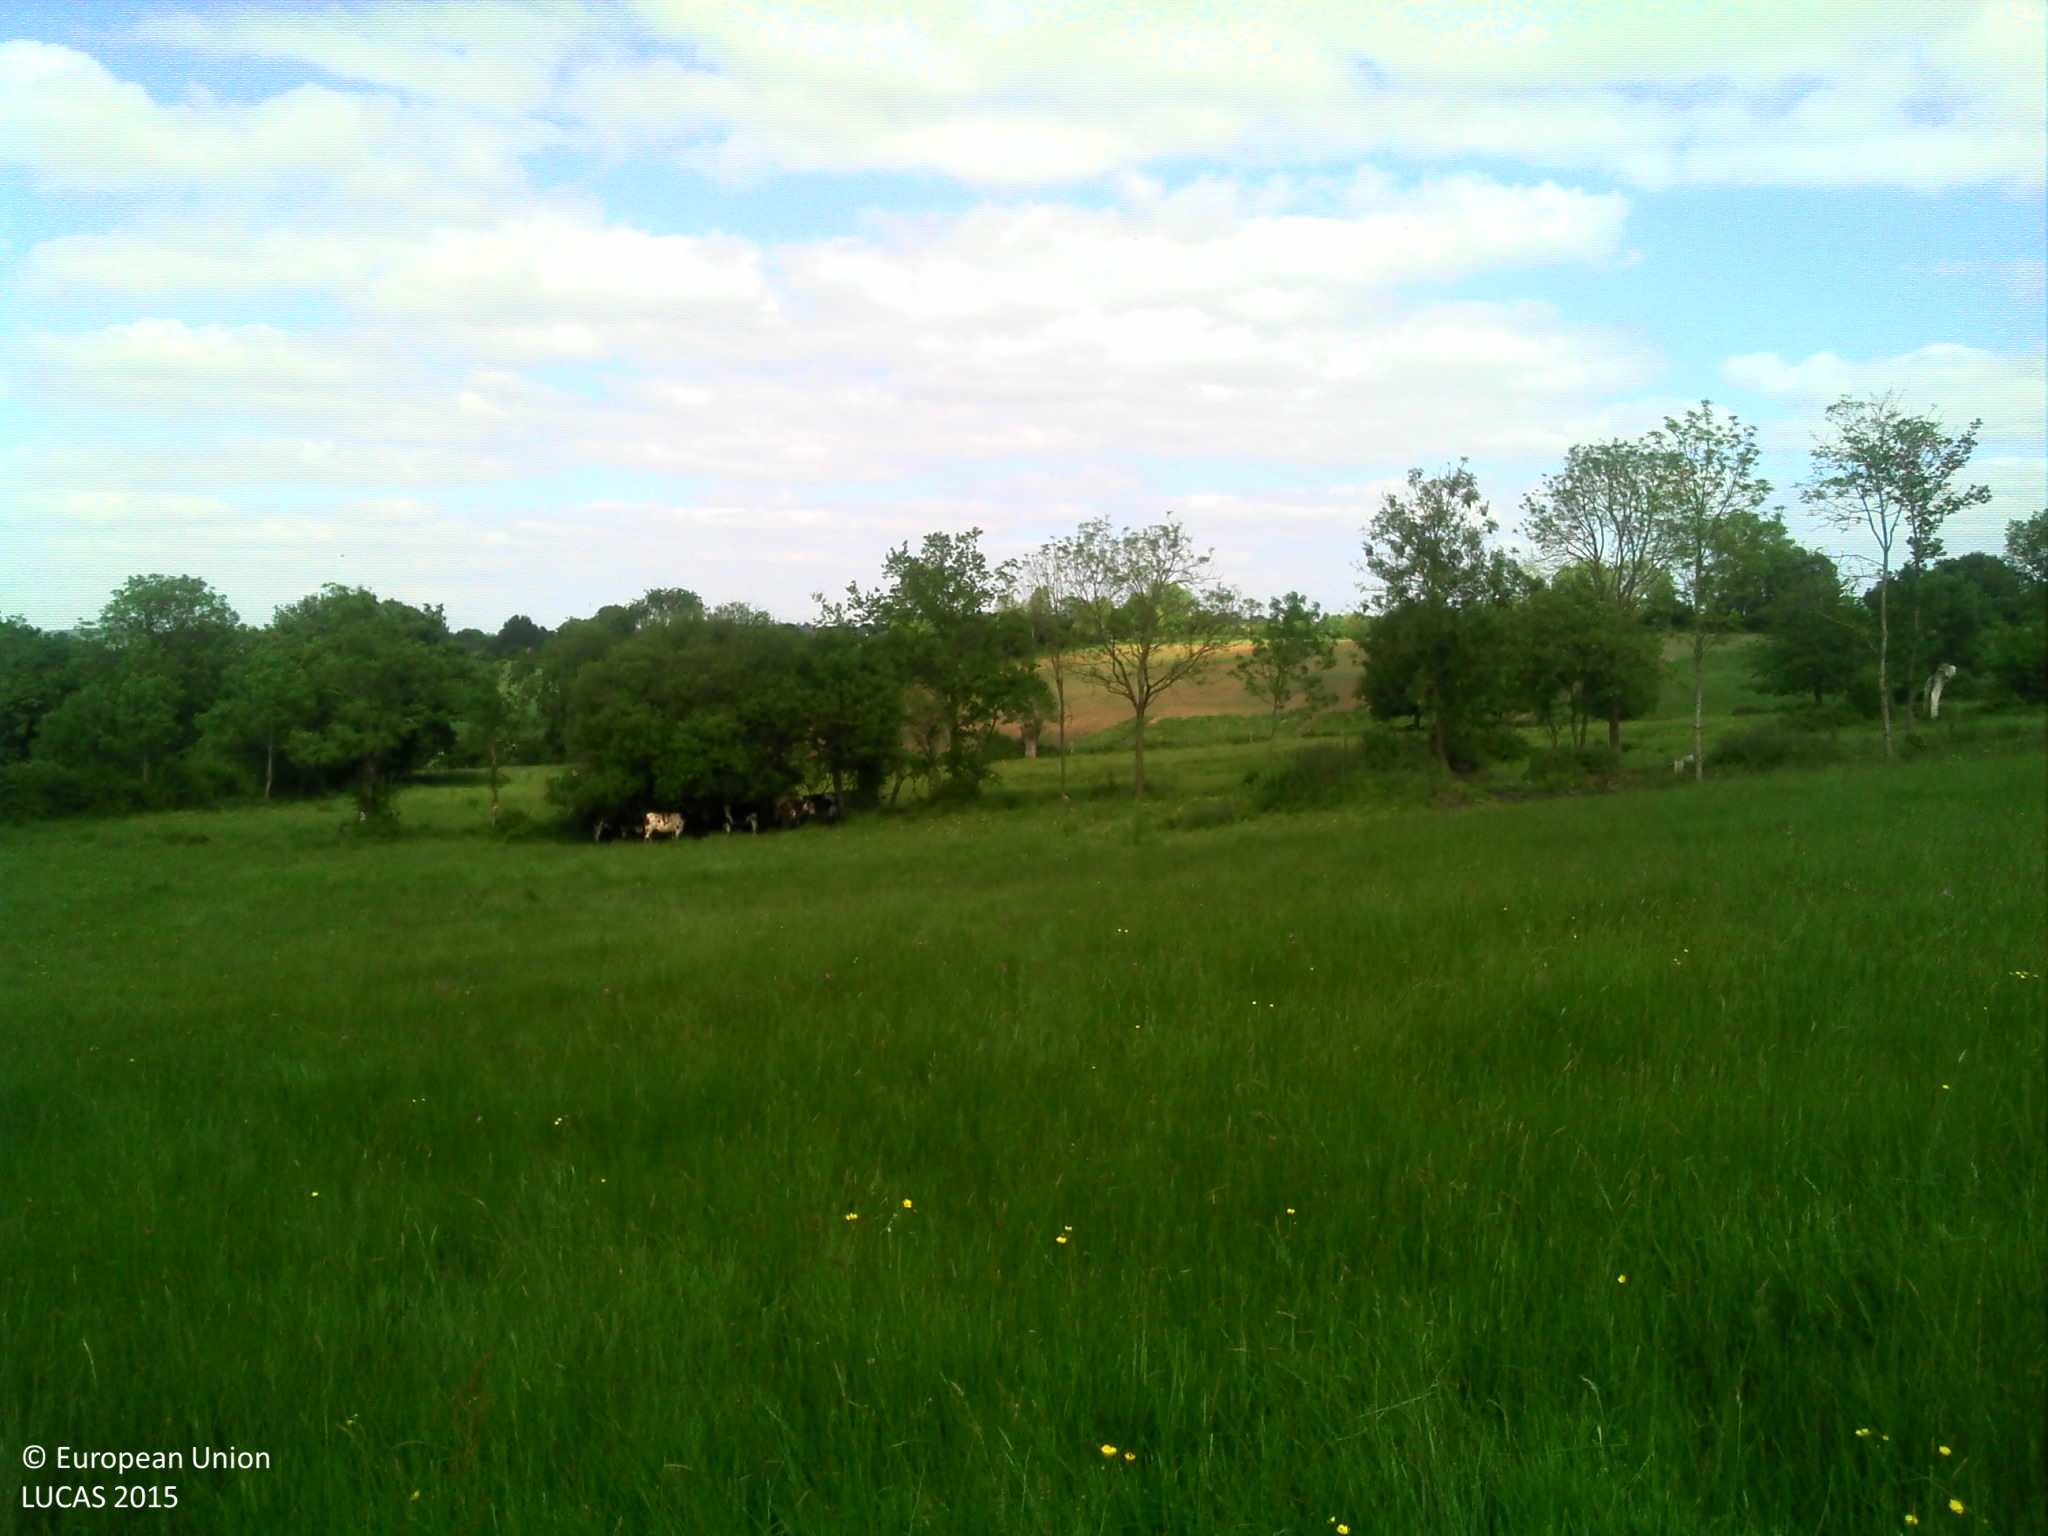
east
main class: Grassland
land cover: Grassland without tree/shrub cover
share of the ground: > 75 %
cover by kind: herbaceous plants 90 %, shrubs 5 %
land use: Agriculture (excluding fallow land and kitchen gardens)
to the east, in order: Grassland without tree/shrub cover; Broadleaved woodland; Other bare soil; Grassland without tree/shrub cover; Abandoned hedges; Grassland without tree/shrub cover; Fences; Grass margins; Maize; Grassland without tree/shrub cover
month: June
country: FR
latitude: 48.8349
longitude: 0.1759
